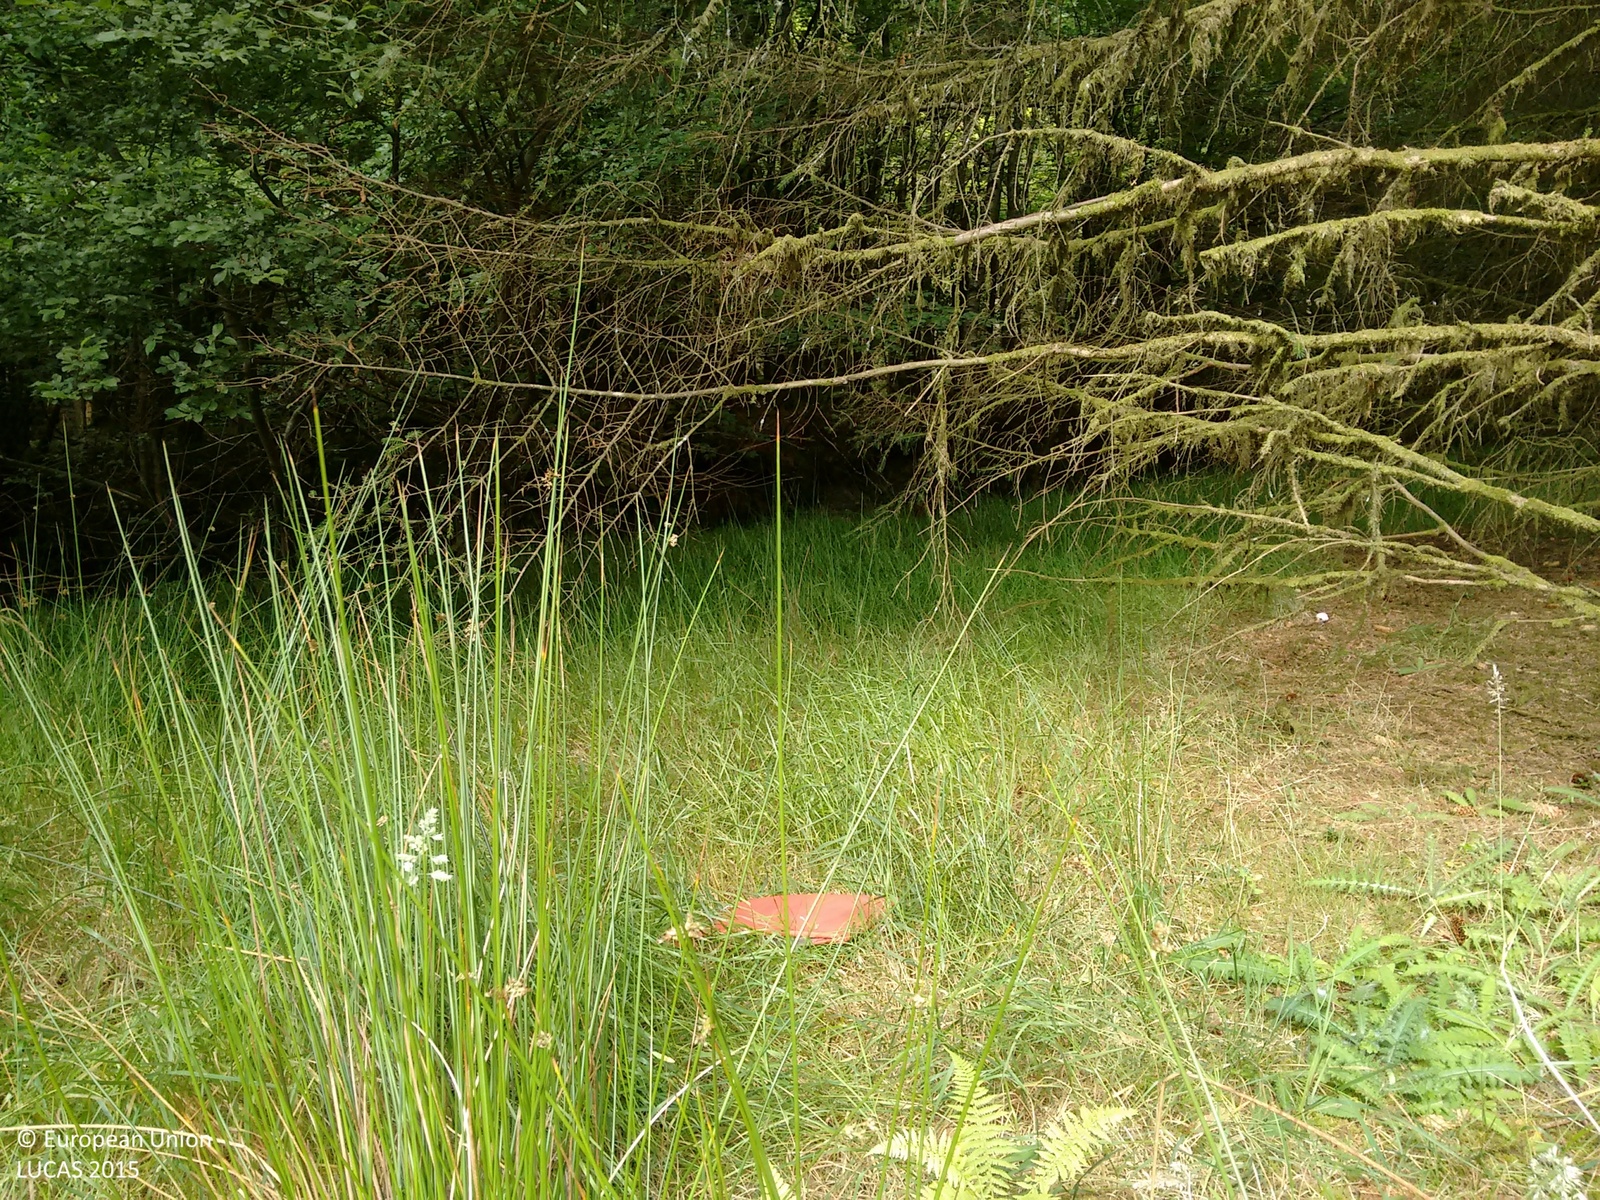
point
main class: Woodland
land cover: Spruce dominated coniferous woodland
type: exotic forest
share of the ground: > 75 %
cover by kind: coniferous forest trees 80 %, broadleaved forest trees 20 %
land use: Forestry
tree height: > 5 m
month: August
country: IE
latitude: 53.0425
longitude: -7.5669
